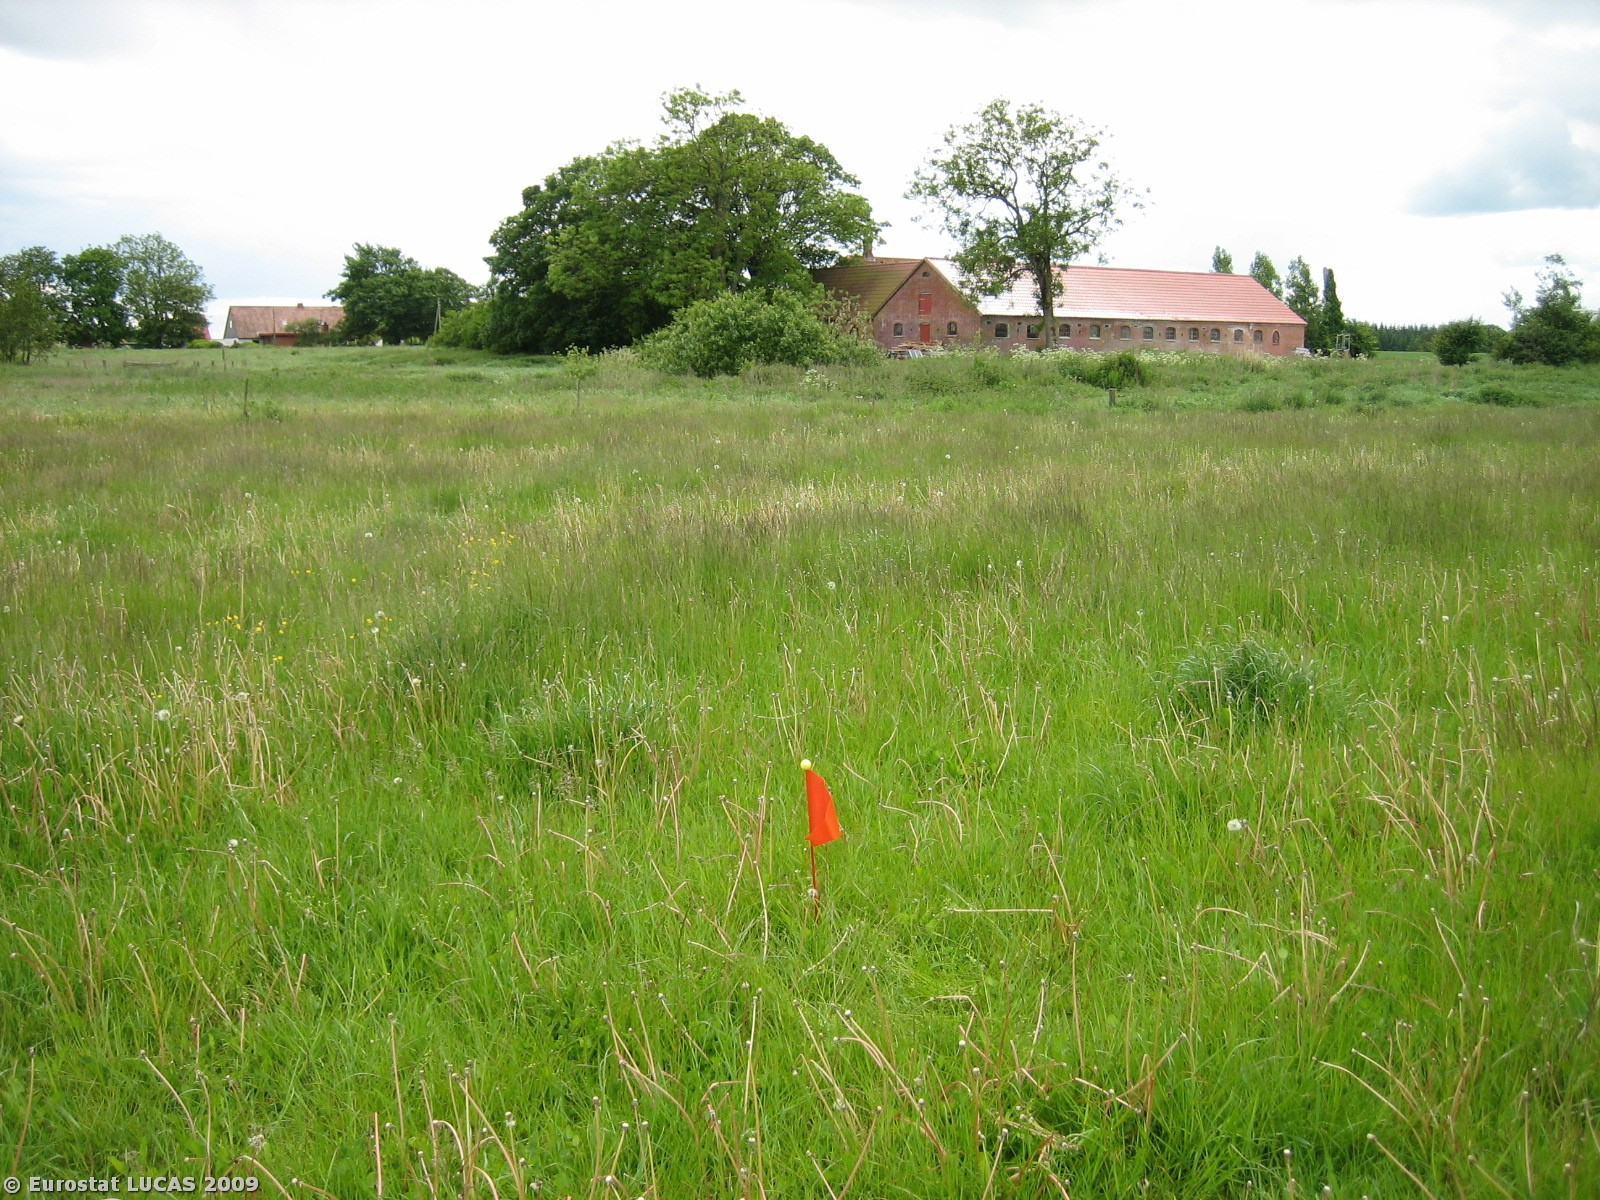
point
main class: Grassland
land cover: Grassland without tree/shrub cover
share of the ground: > 75 %
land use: Agriculture (excluding fallow land and kitchen gardens)
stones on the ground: < 10 %
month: June
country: DK
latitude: 56.2956
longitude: 9.9193
